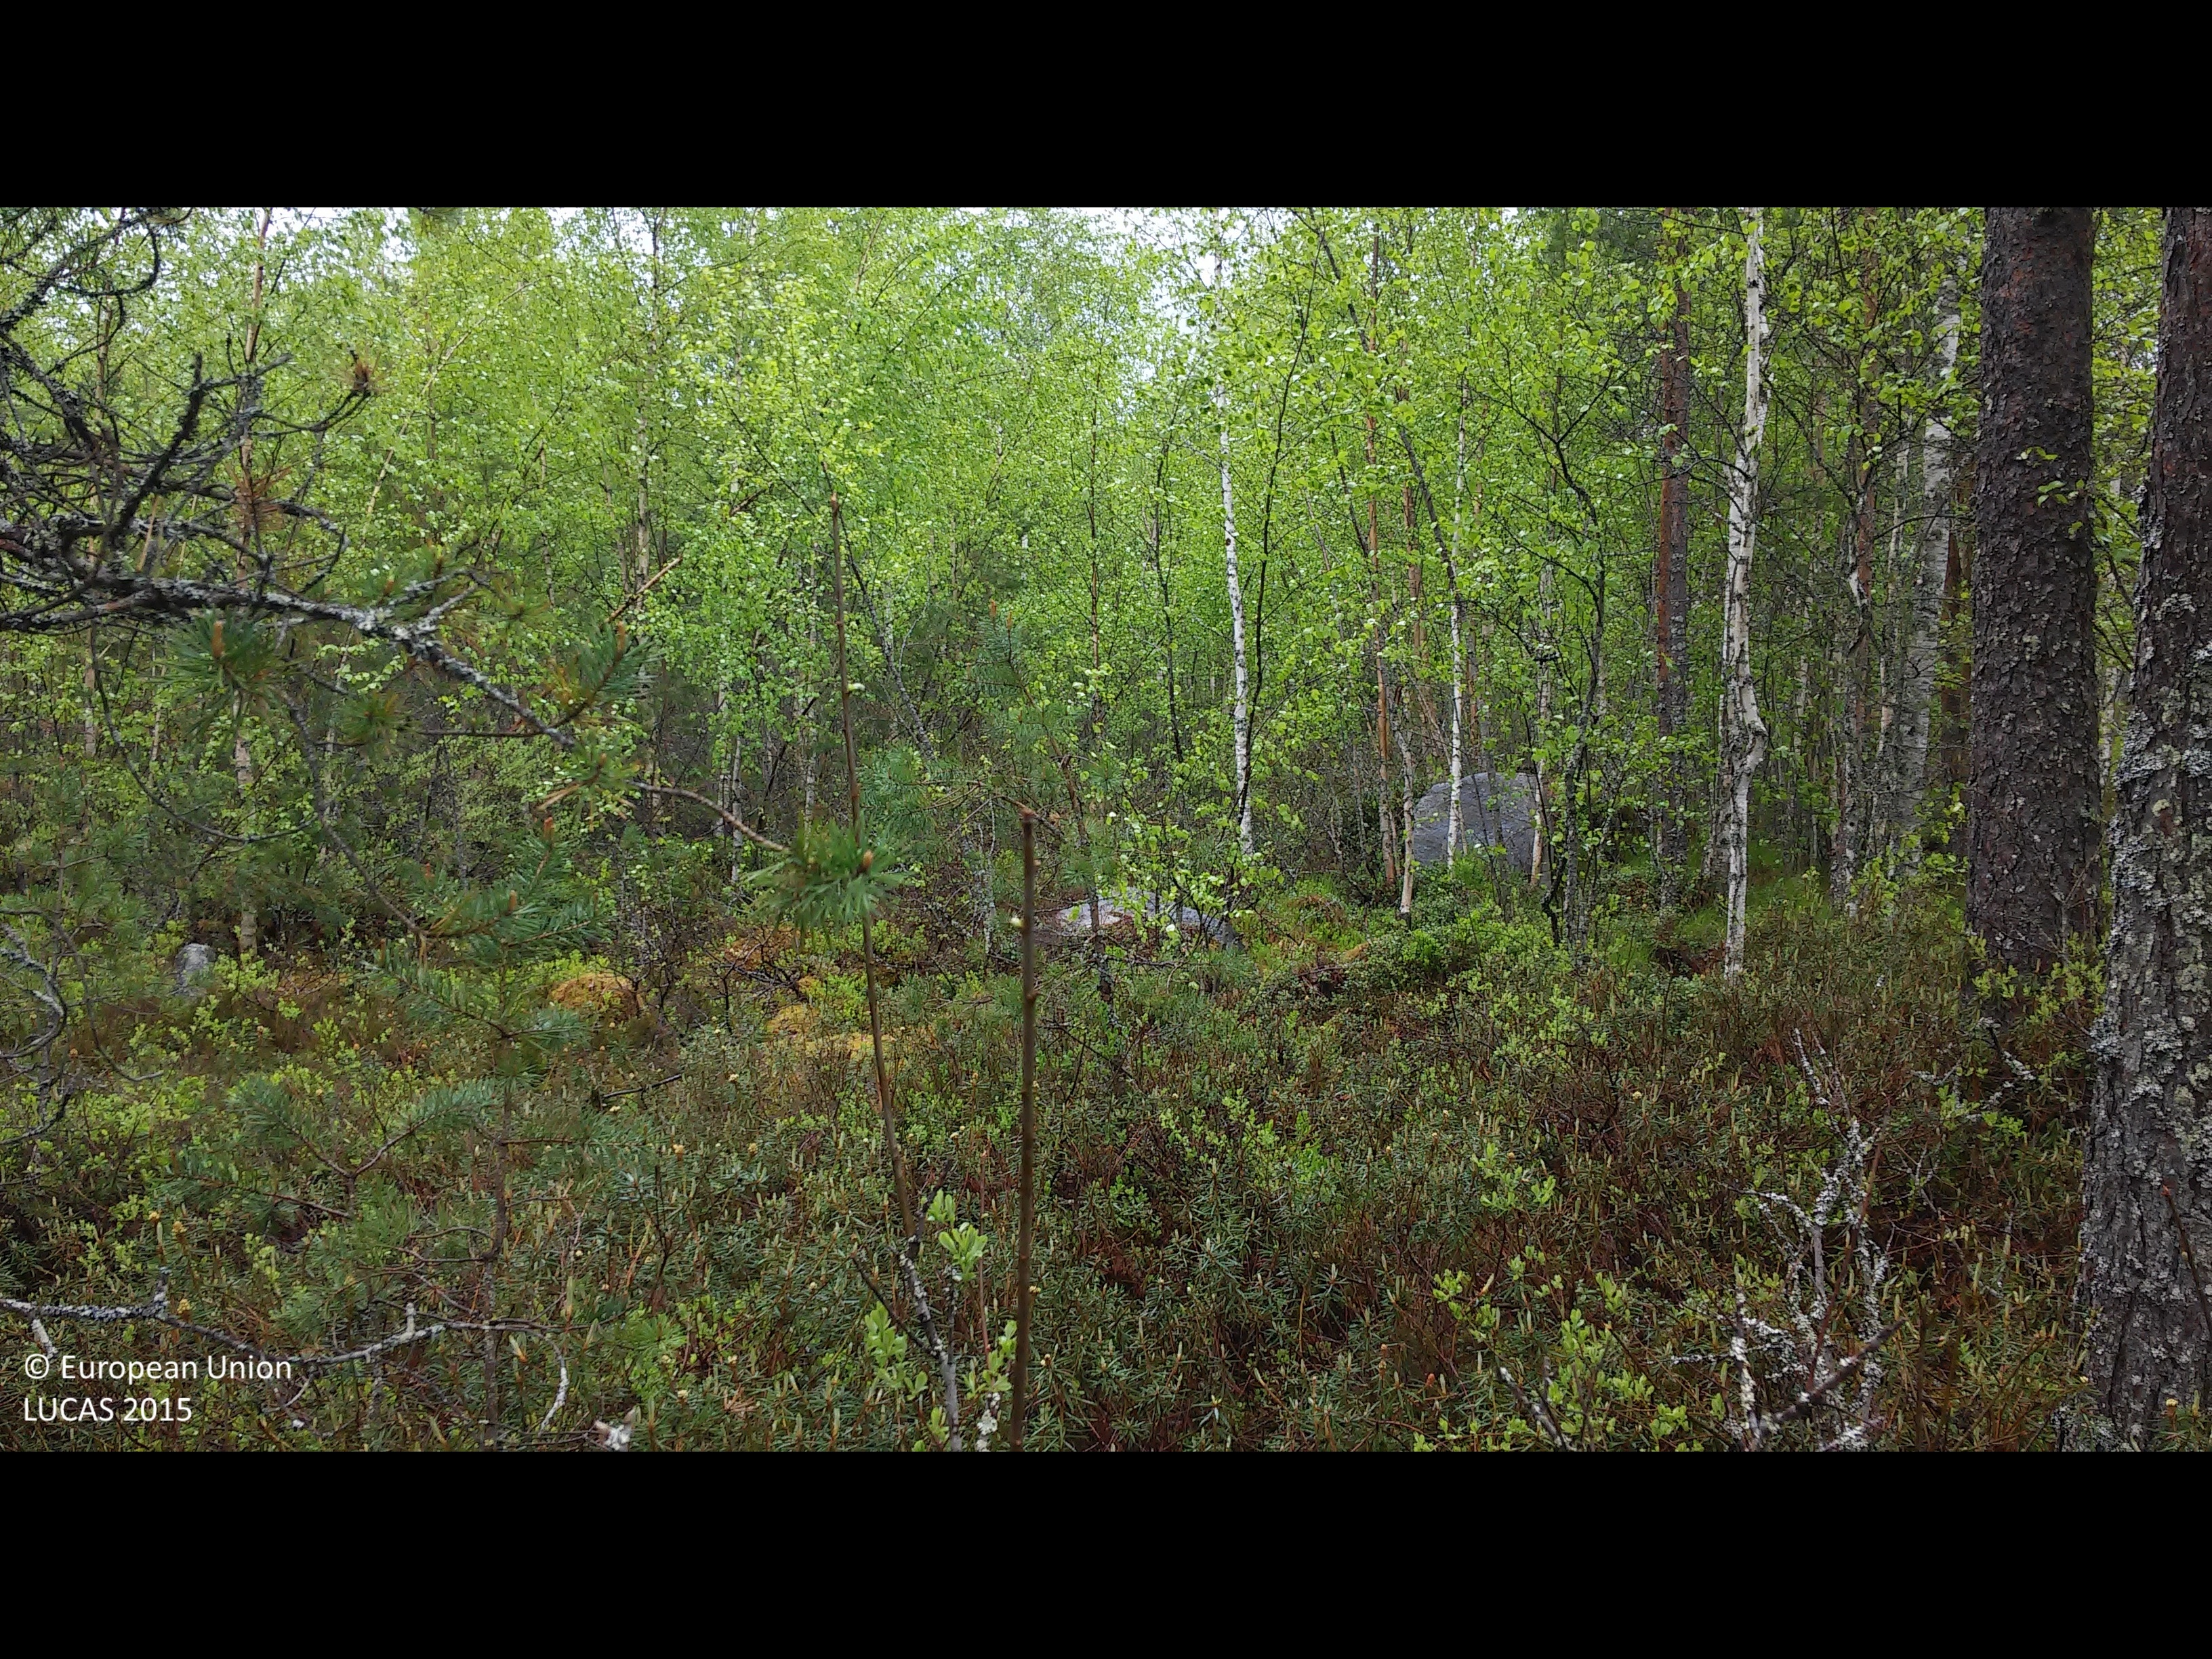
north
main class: Woodland
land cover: Pine dominated mixed woodland
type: boreal forest
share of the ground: > 75 %
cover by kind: coniferous forest trees 70 %, broadleaved forest trees 25 %, lichens and mosses 5 %
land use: Forestry
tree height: > 5 m
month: June
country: FI
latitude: 63.7590
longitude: 24.1595
